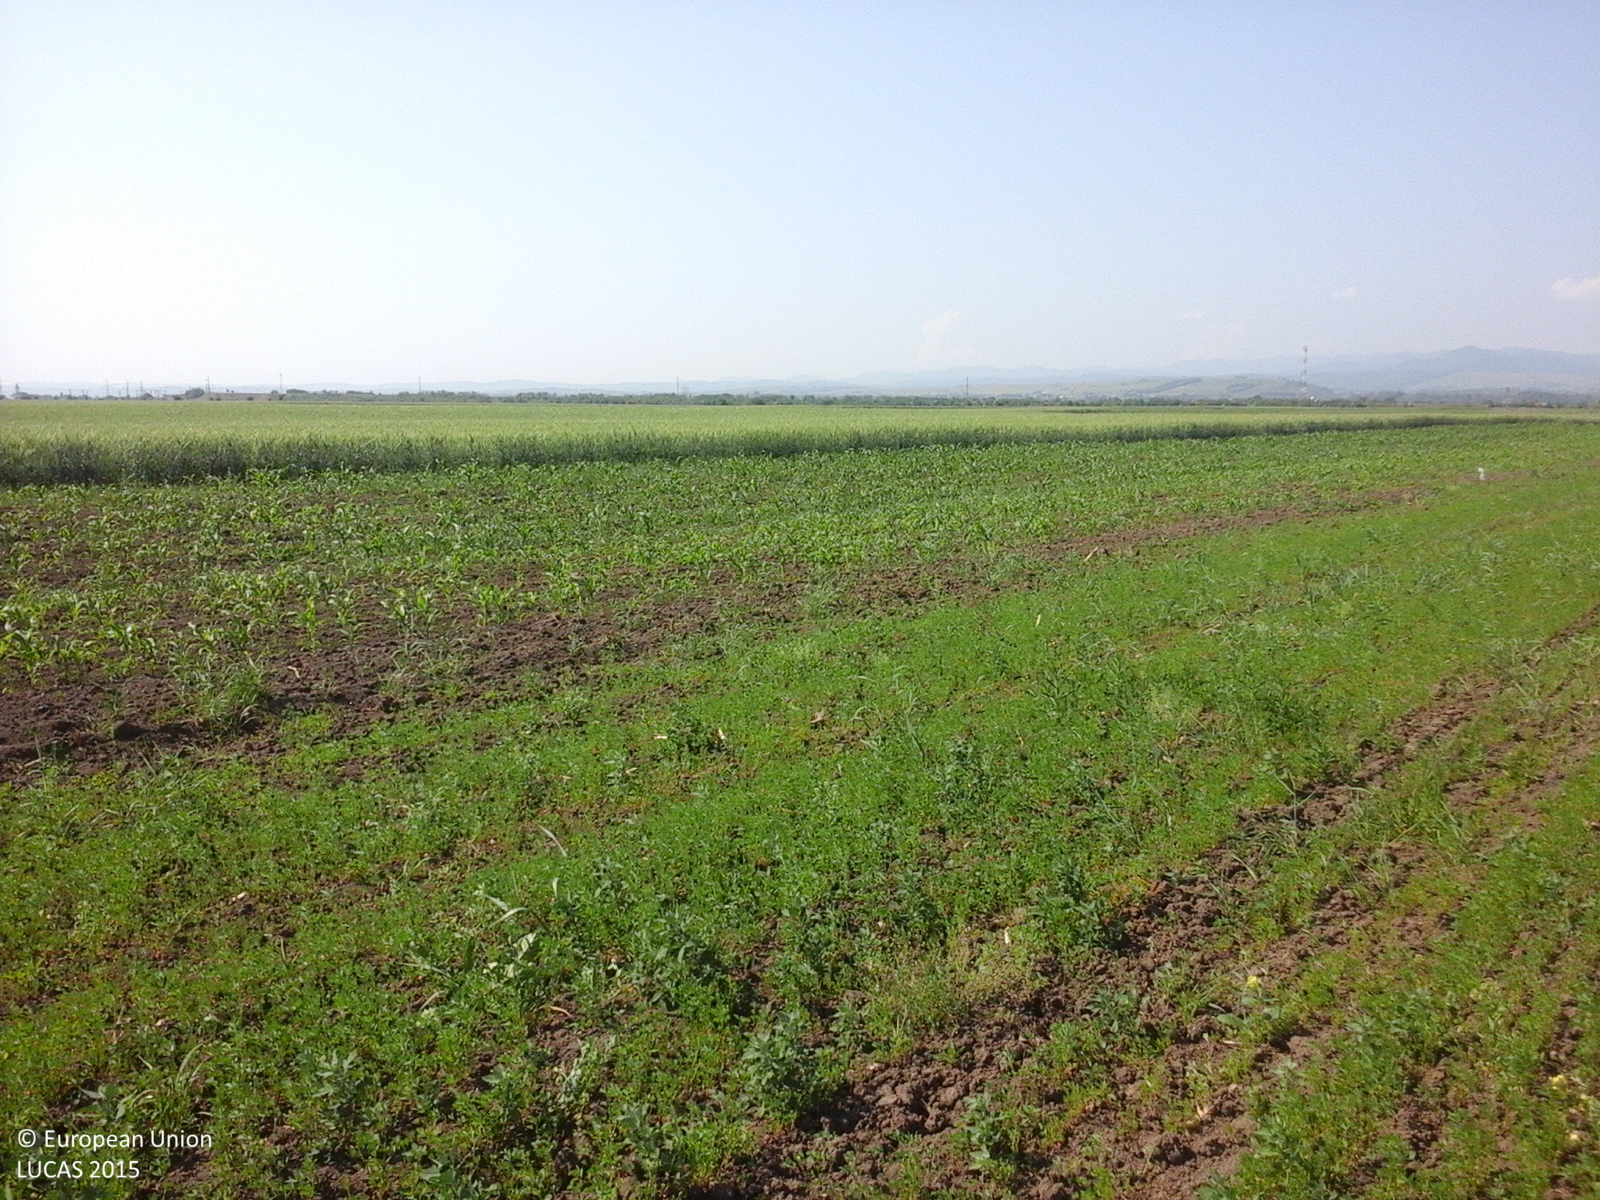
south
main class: Cropland
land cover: Lucerne
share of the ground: > 75 %
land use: Agriculture (excluding fallow land and kitchen gardens)
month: June
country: RO
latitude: 46.8301
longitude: 26.5650
